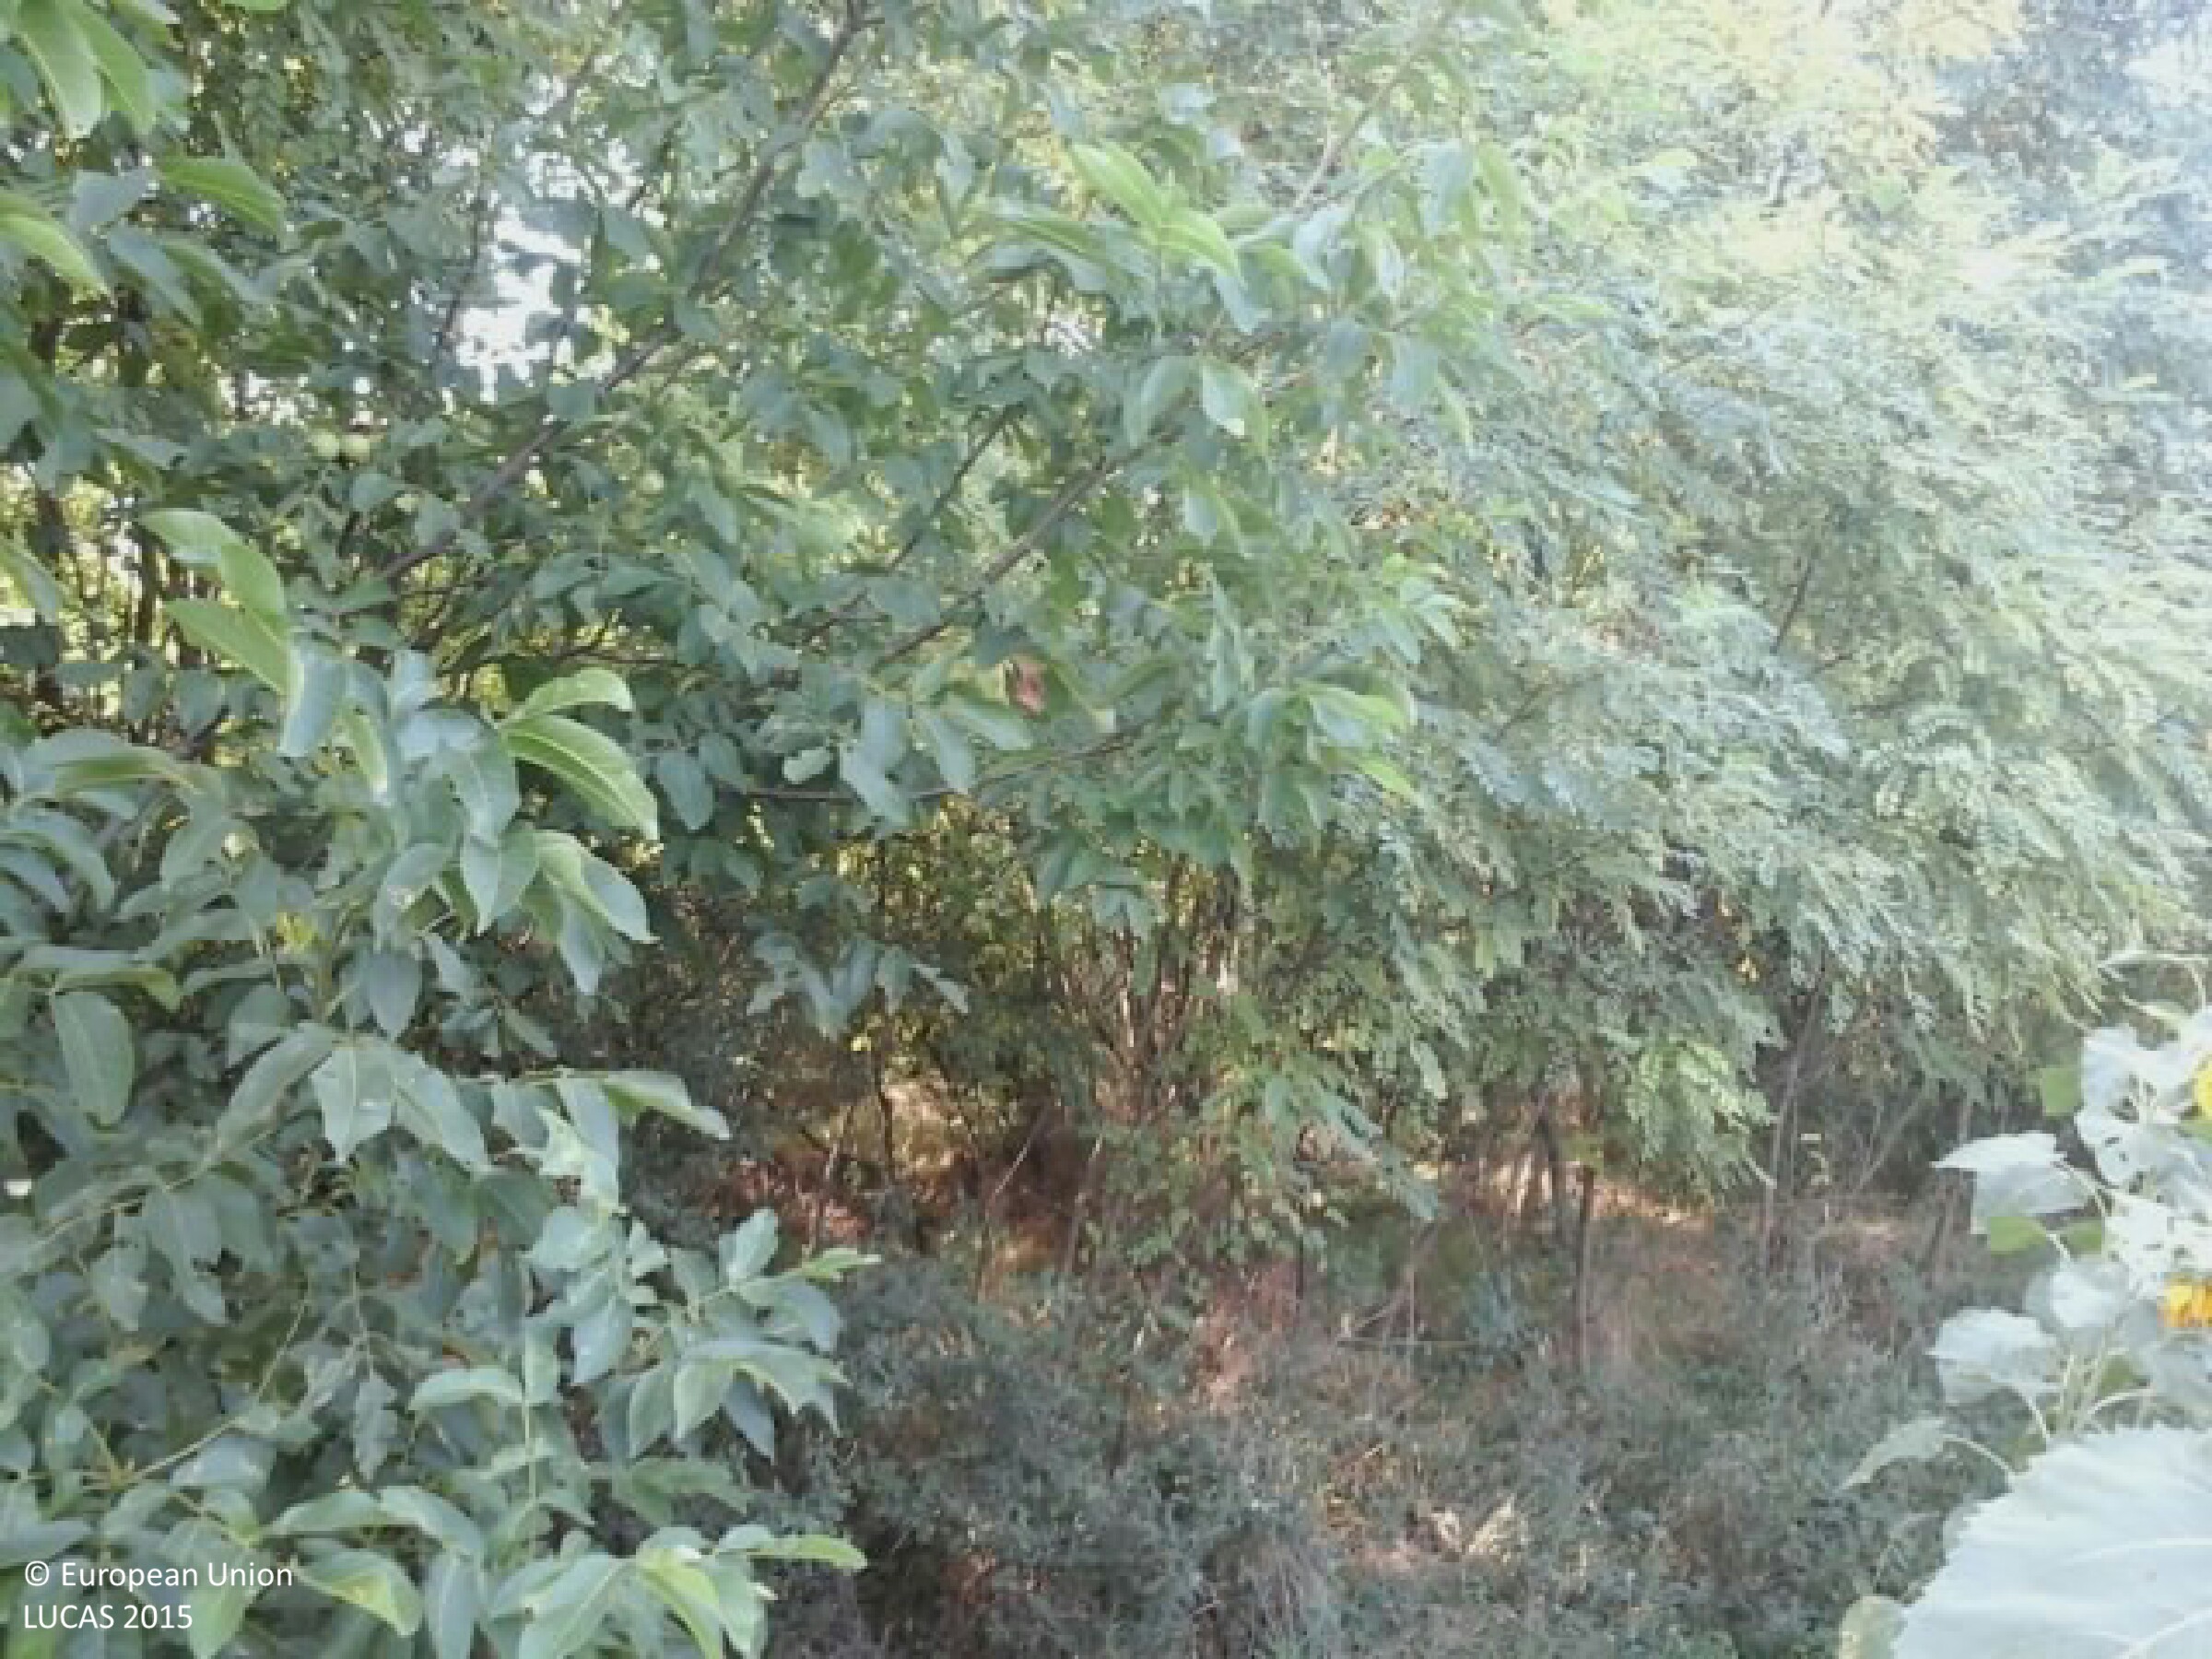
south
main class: Cropland
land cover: Sunflower
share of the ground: > 75 %
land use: Agriculture (excluding fallow land and kitchen gardens)
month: August
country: HU
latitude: 46.6353
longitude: 18.1730
